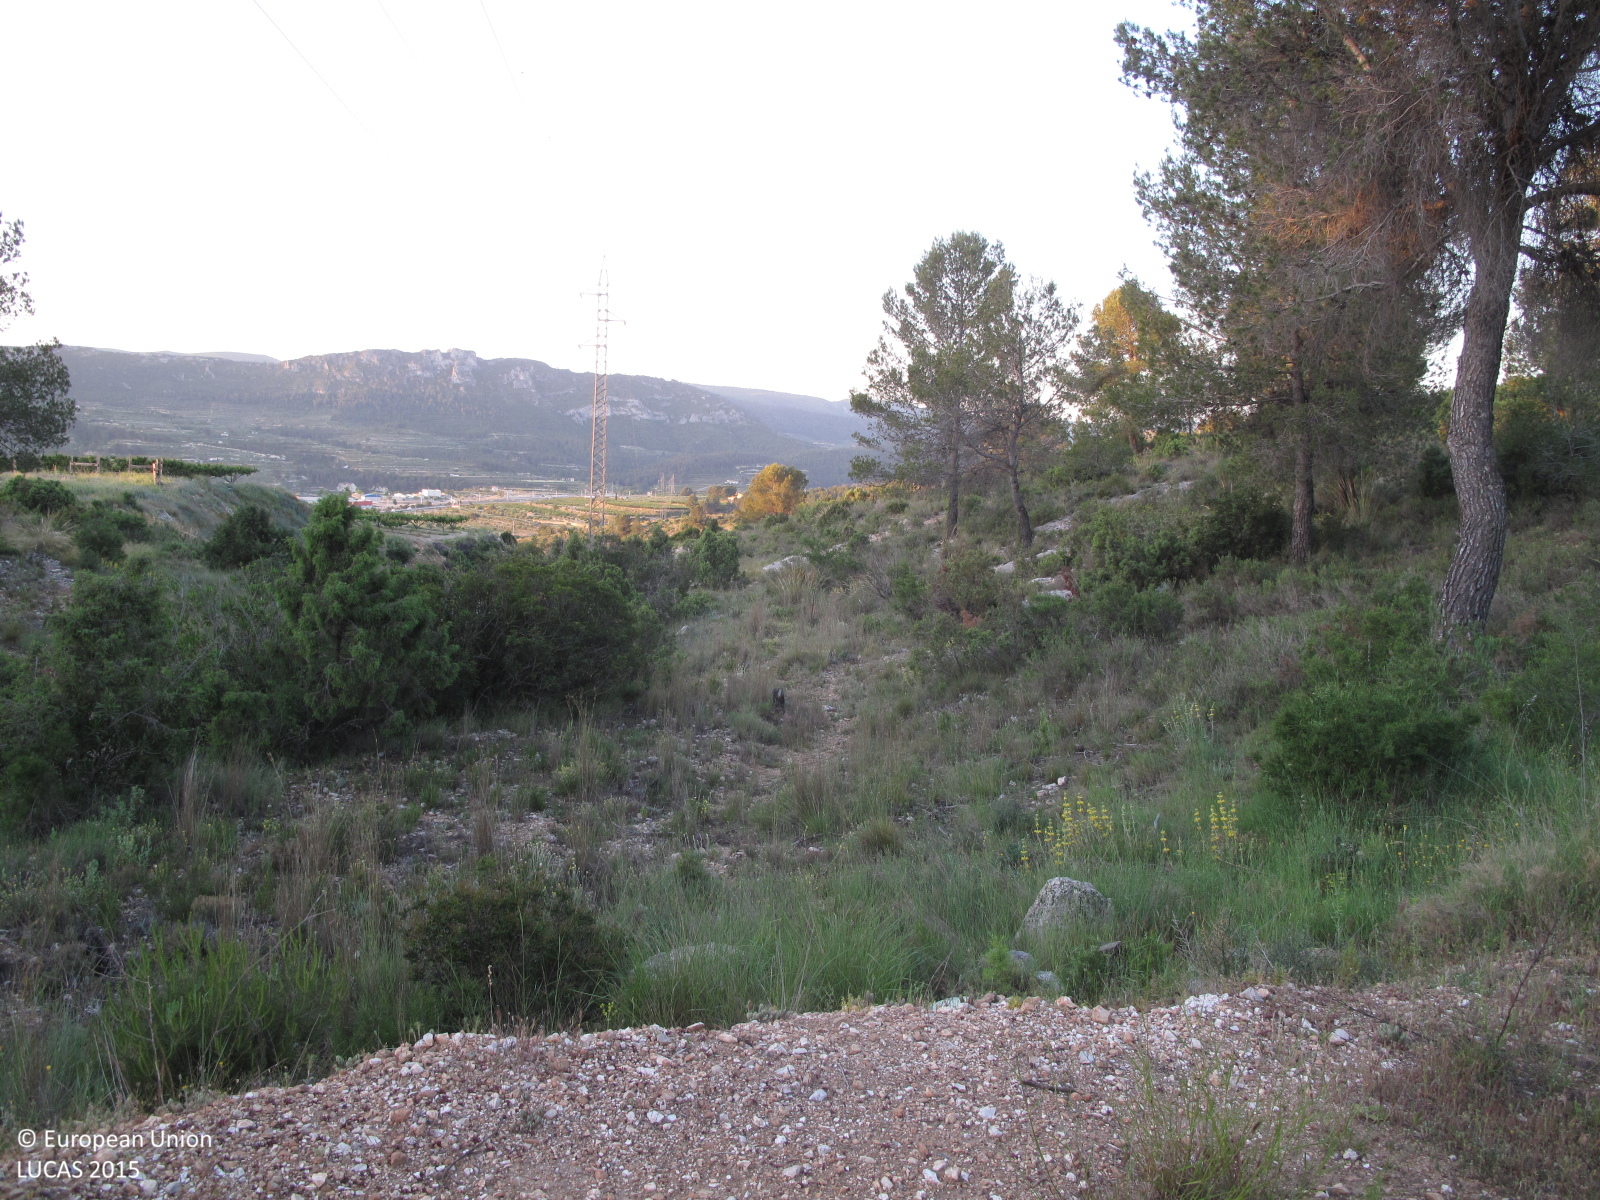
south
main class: Cropland
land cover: Olive groves
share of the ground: 25 - 50 %
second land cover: Spontaneously vegetated surfaces
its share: 25 - 50 %
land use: Agriculture (excluding fallow land and kitchen gardens)
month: May
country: ES
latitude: 38.8878
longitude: -0.7719
